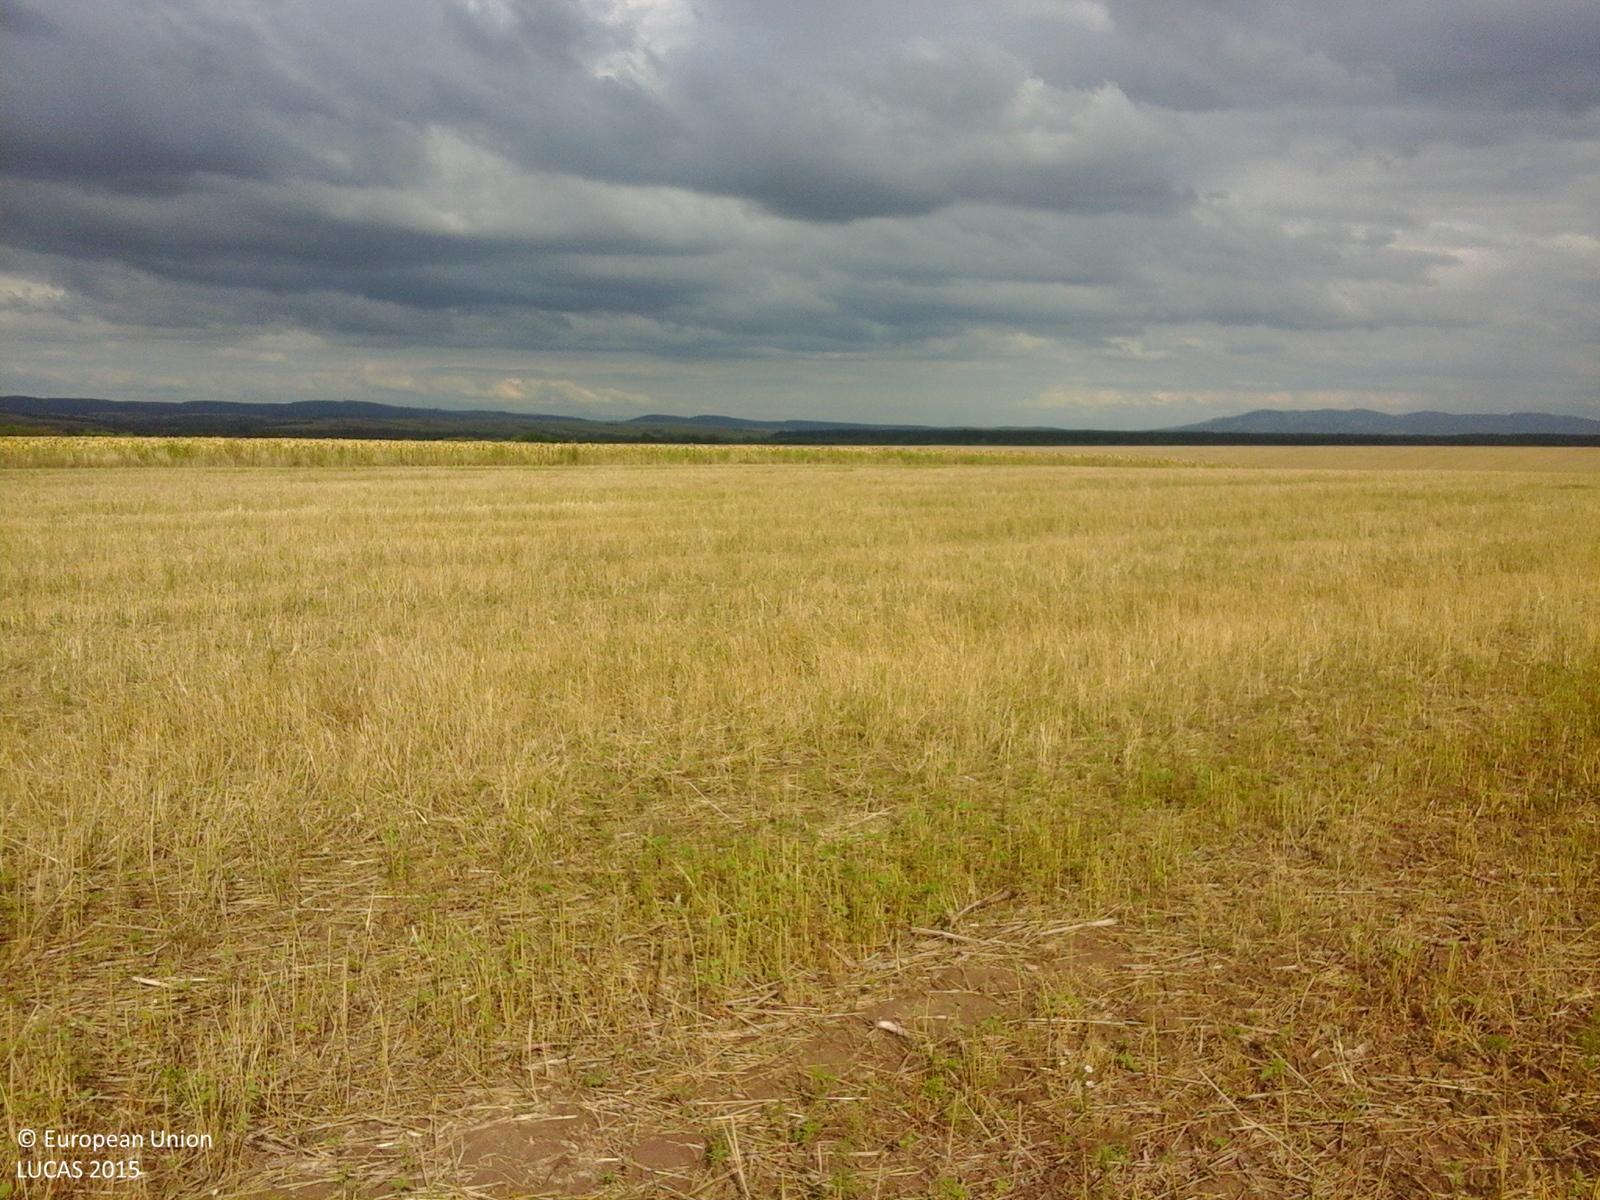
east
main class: Cropland
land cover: Common wheat
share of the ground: 25 - 50 %
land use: Agriculture (excluding fallow land and kitchen gardens)
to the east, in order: Common wheat; Grass margins; Sunflower; Tracks; Spontaneously vegetated surfaces
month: August
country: RO
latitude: 45.5239
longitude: 21.5429
